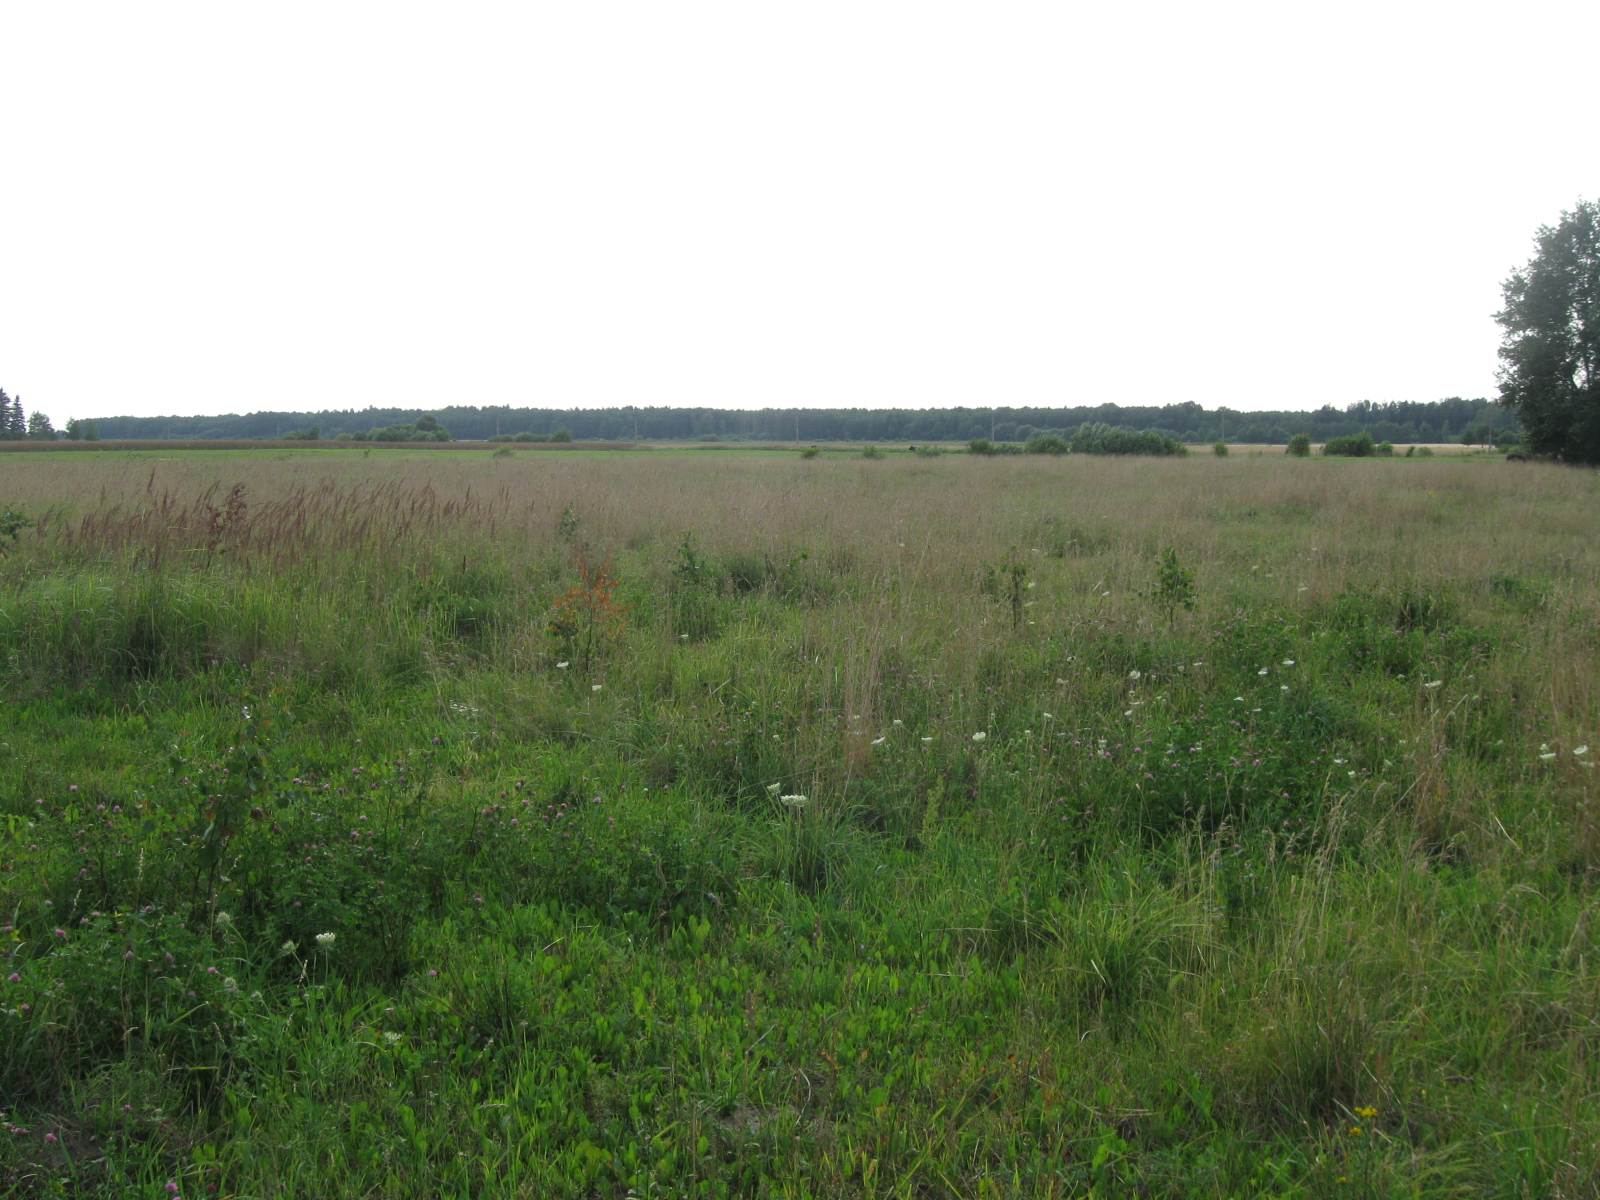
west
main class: Grassland
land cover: Grassland with sparse tree/shrub cover
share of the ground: > 75 %
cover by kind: herbaceous plants 90 %, broadleaved forest trees 5 %, shrubs 5 %
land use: Agriculture (excluding fallow land and kitchen gardens)
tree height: < 5 m
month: July
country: LT
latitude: 54.6864
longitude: 23.8160
